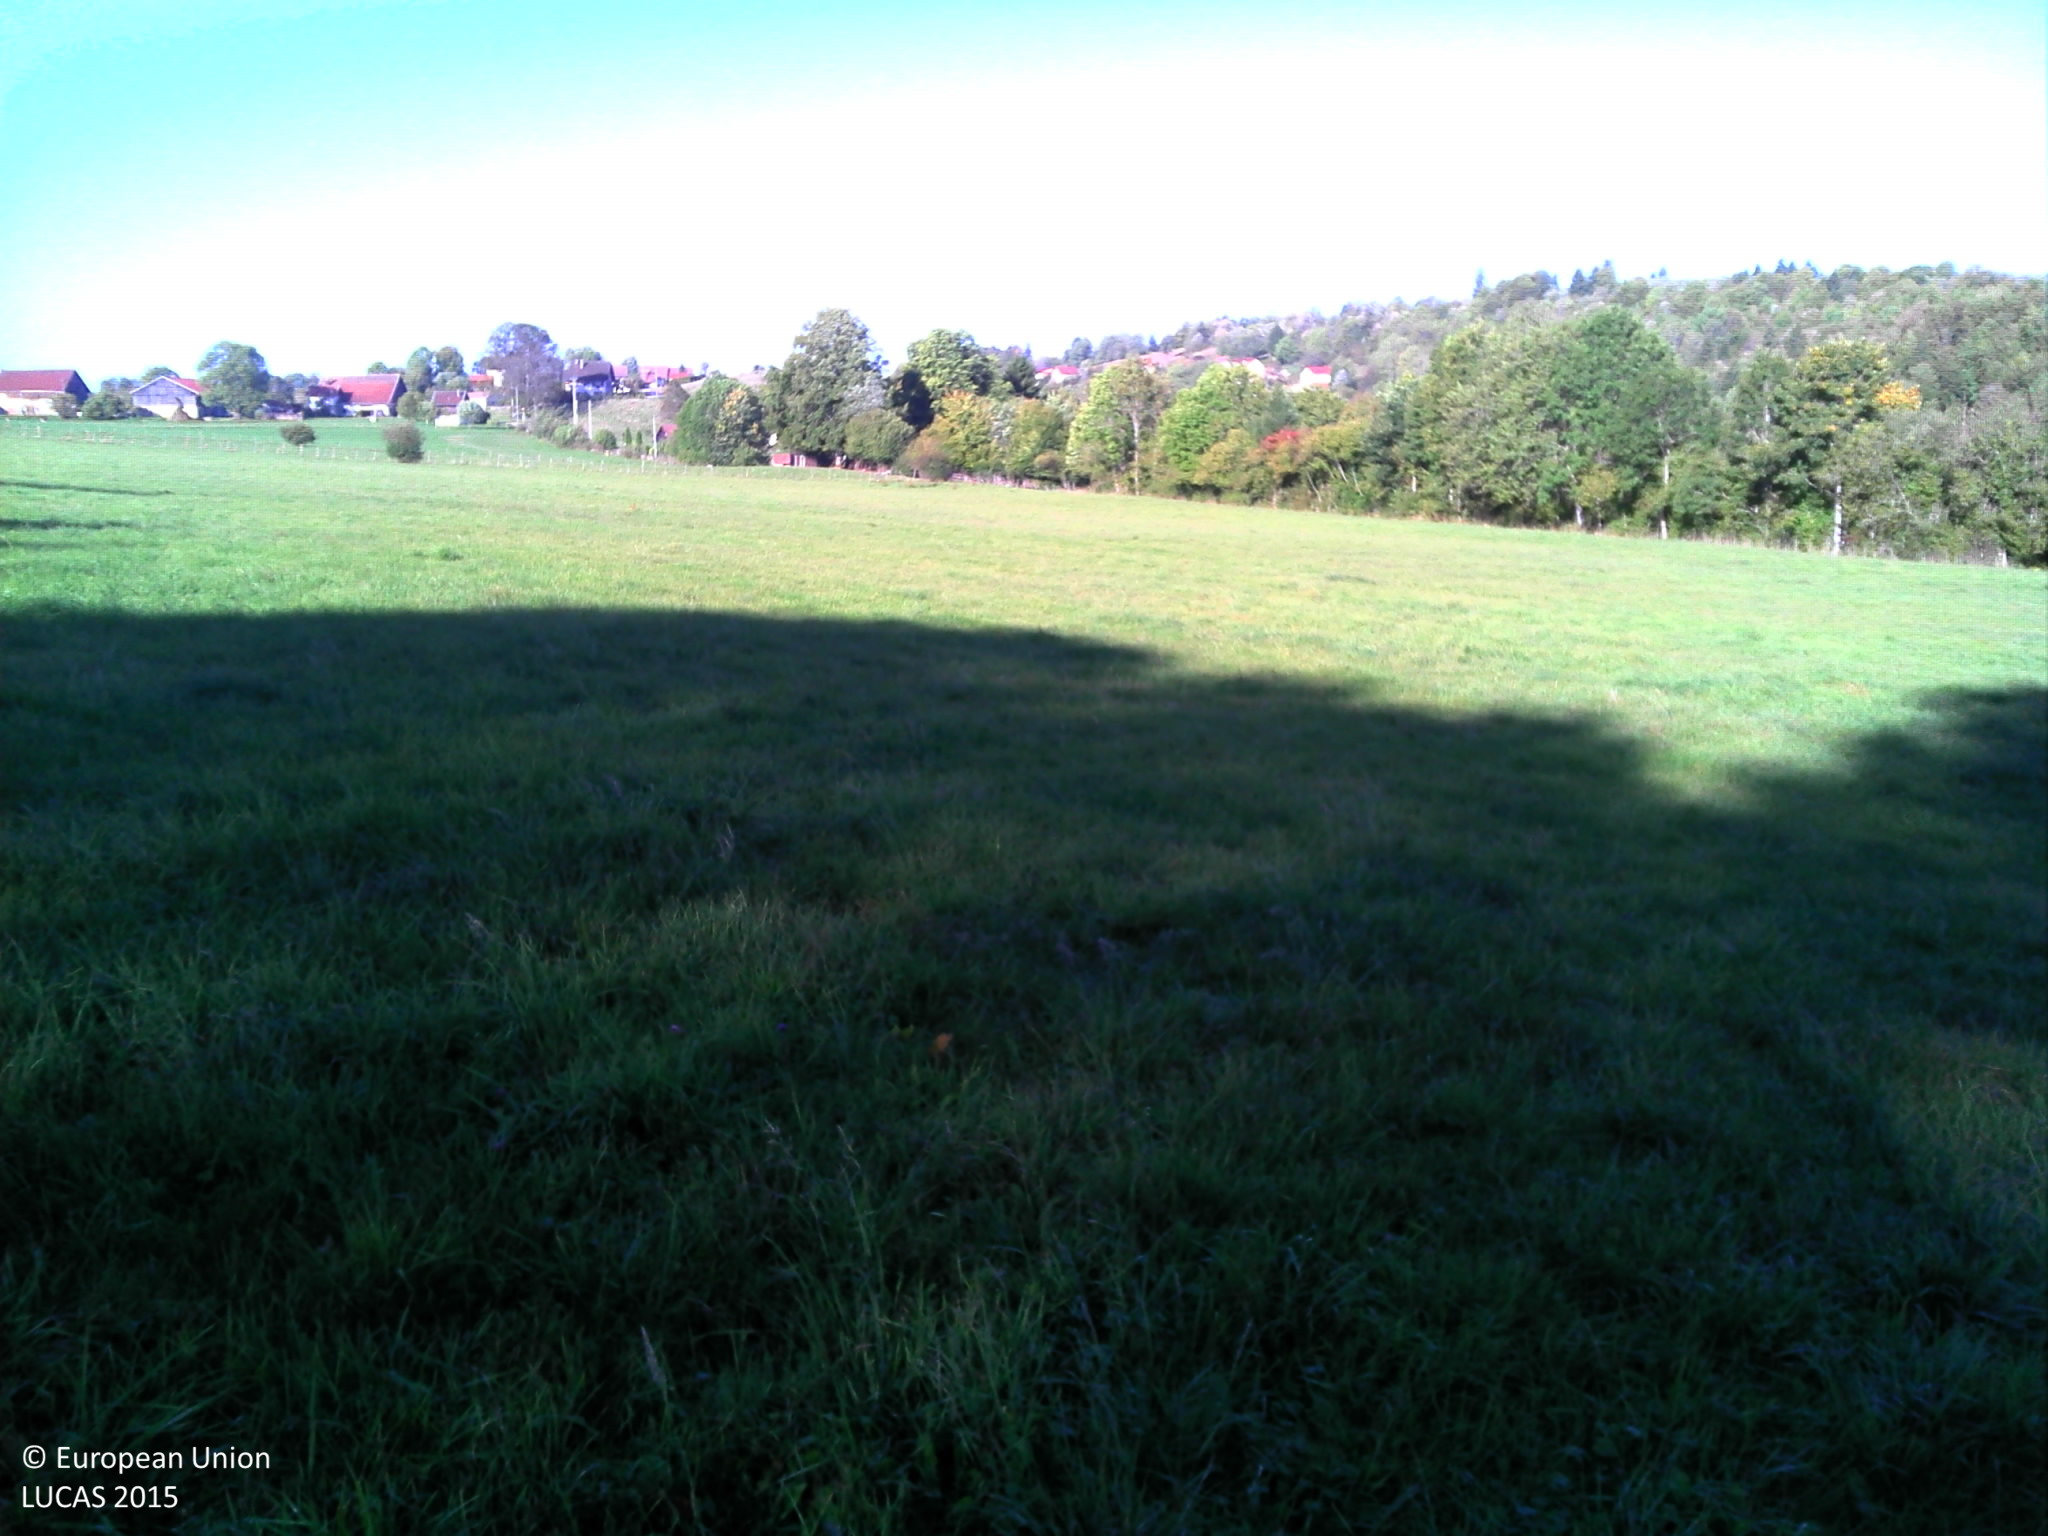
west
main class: Grassland
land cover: Grassland without tree/shrub cover
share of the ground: > 75 %
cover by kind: herbaceous plants 100 %
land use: Agriculture (excluding fallow land and kitchen gardens)
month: September
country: FR
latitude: 47.2800
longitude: 6.9217
